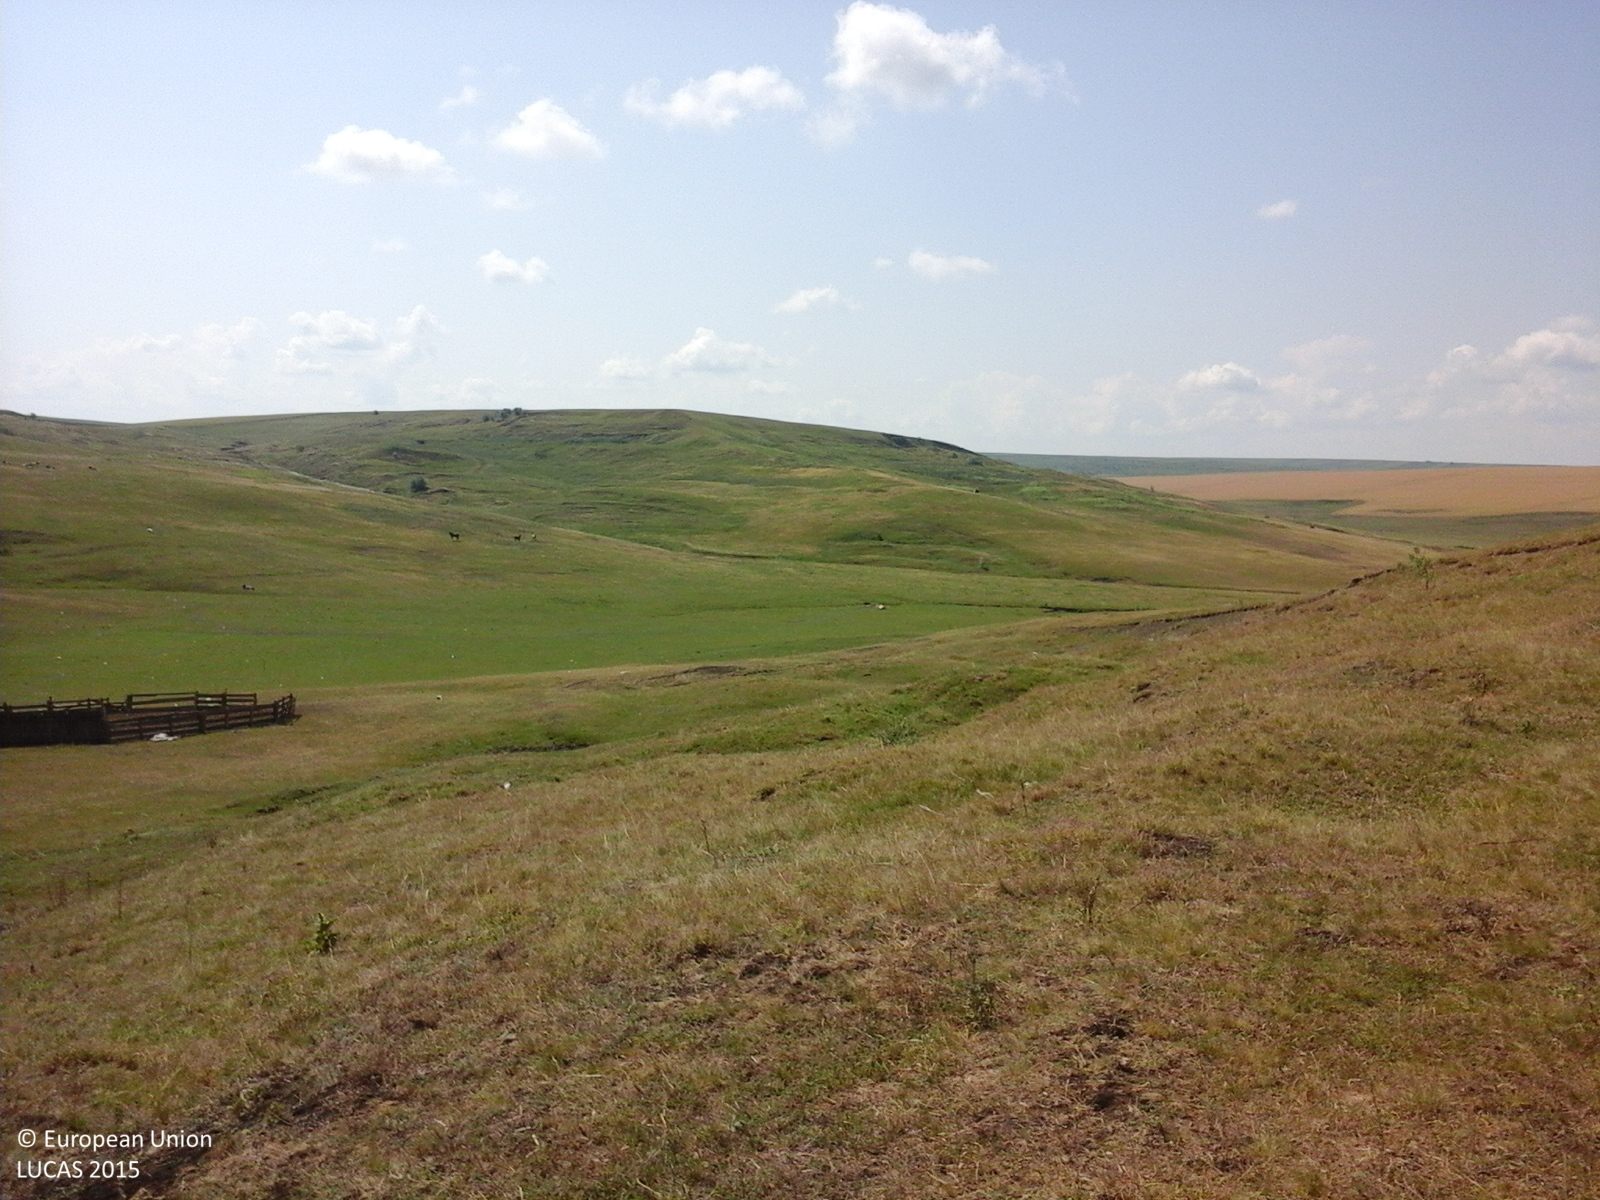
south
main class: Grassland
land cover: Grassland without tree/shrub cover
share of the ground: > 75 %
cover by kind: herbaceous plants 90 %, unconsolidated bare surface 10 %
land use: Agriculture (excluding fallow land and kitchen gardens)
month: June
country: RO
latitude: 47.9461
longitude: 26.7131
